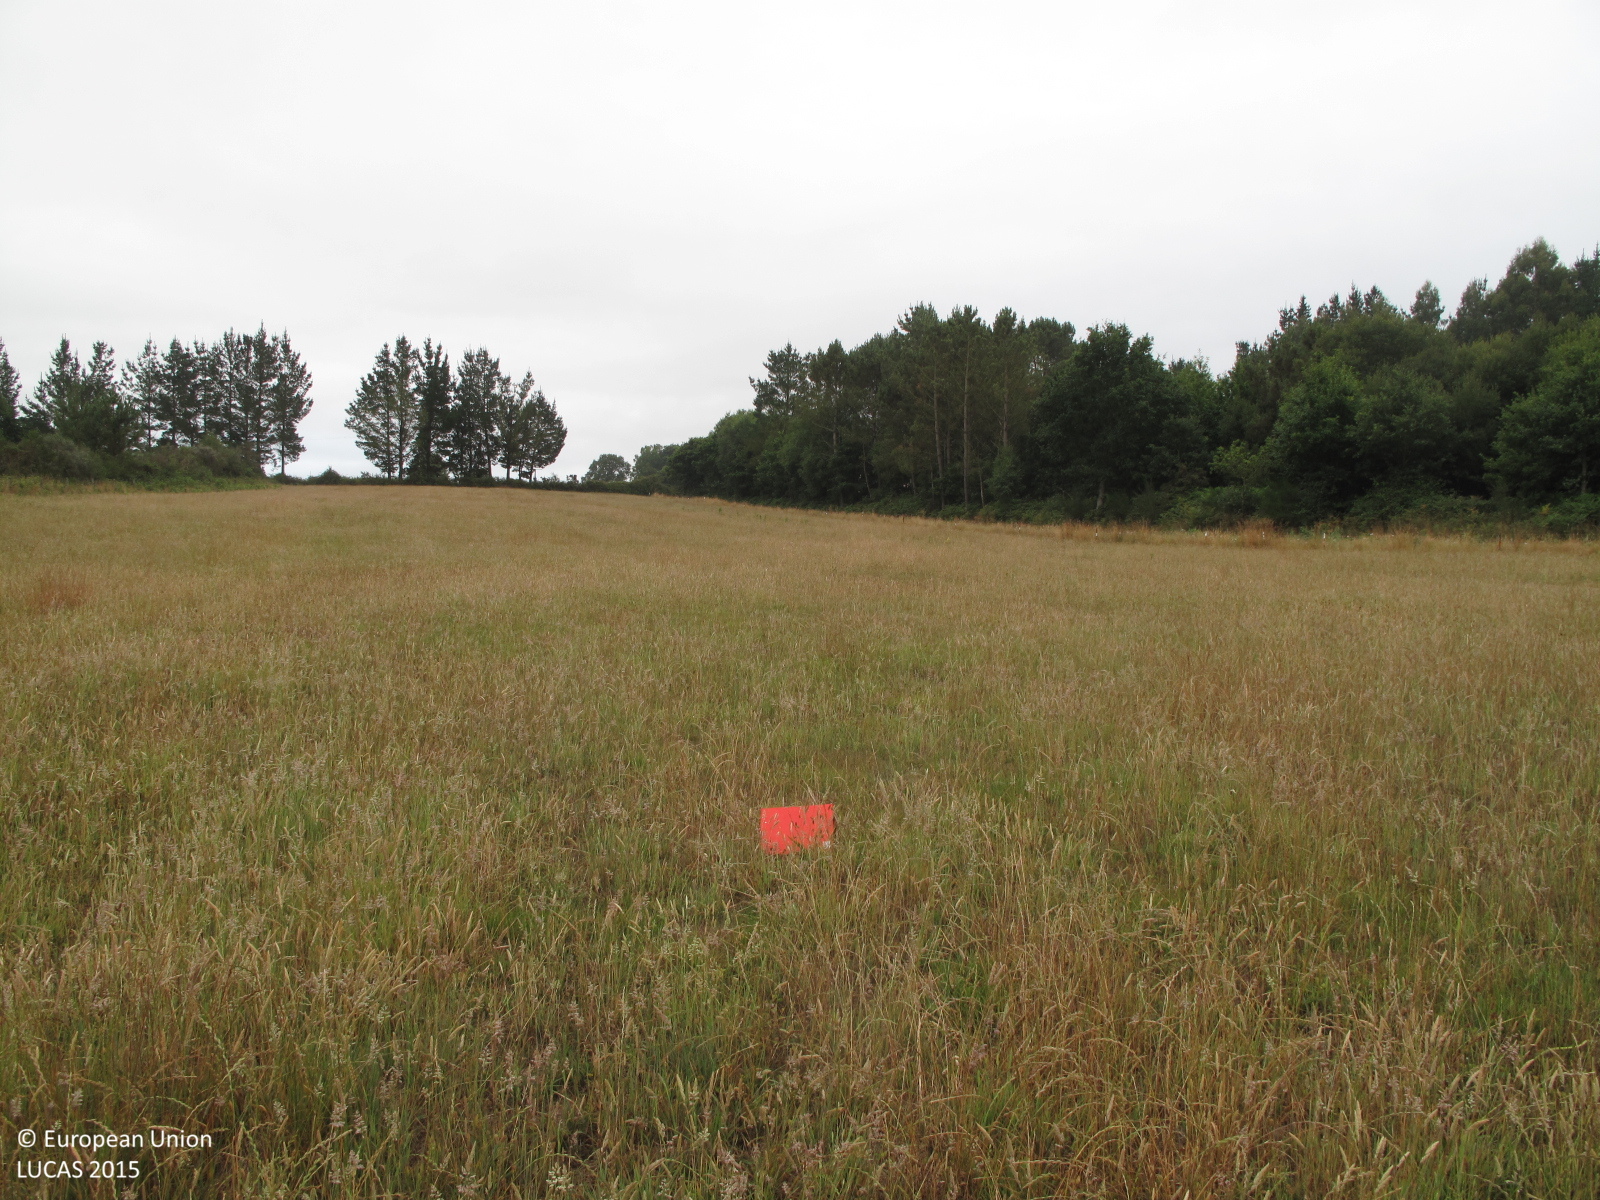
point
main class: Grassland
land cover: Grassland without tree/shrub cover
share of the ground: > 75 %
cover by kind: herbaceous plants 100 %
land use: Agriculture (excluding fallow land and kitchen gardens)
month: July
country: ES
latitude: 43.1769
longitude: -7.9406
